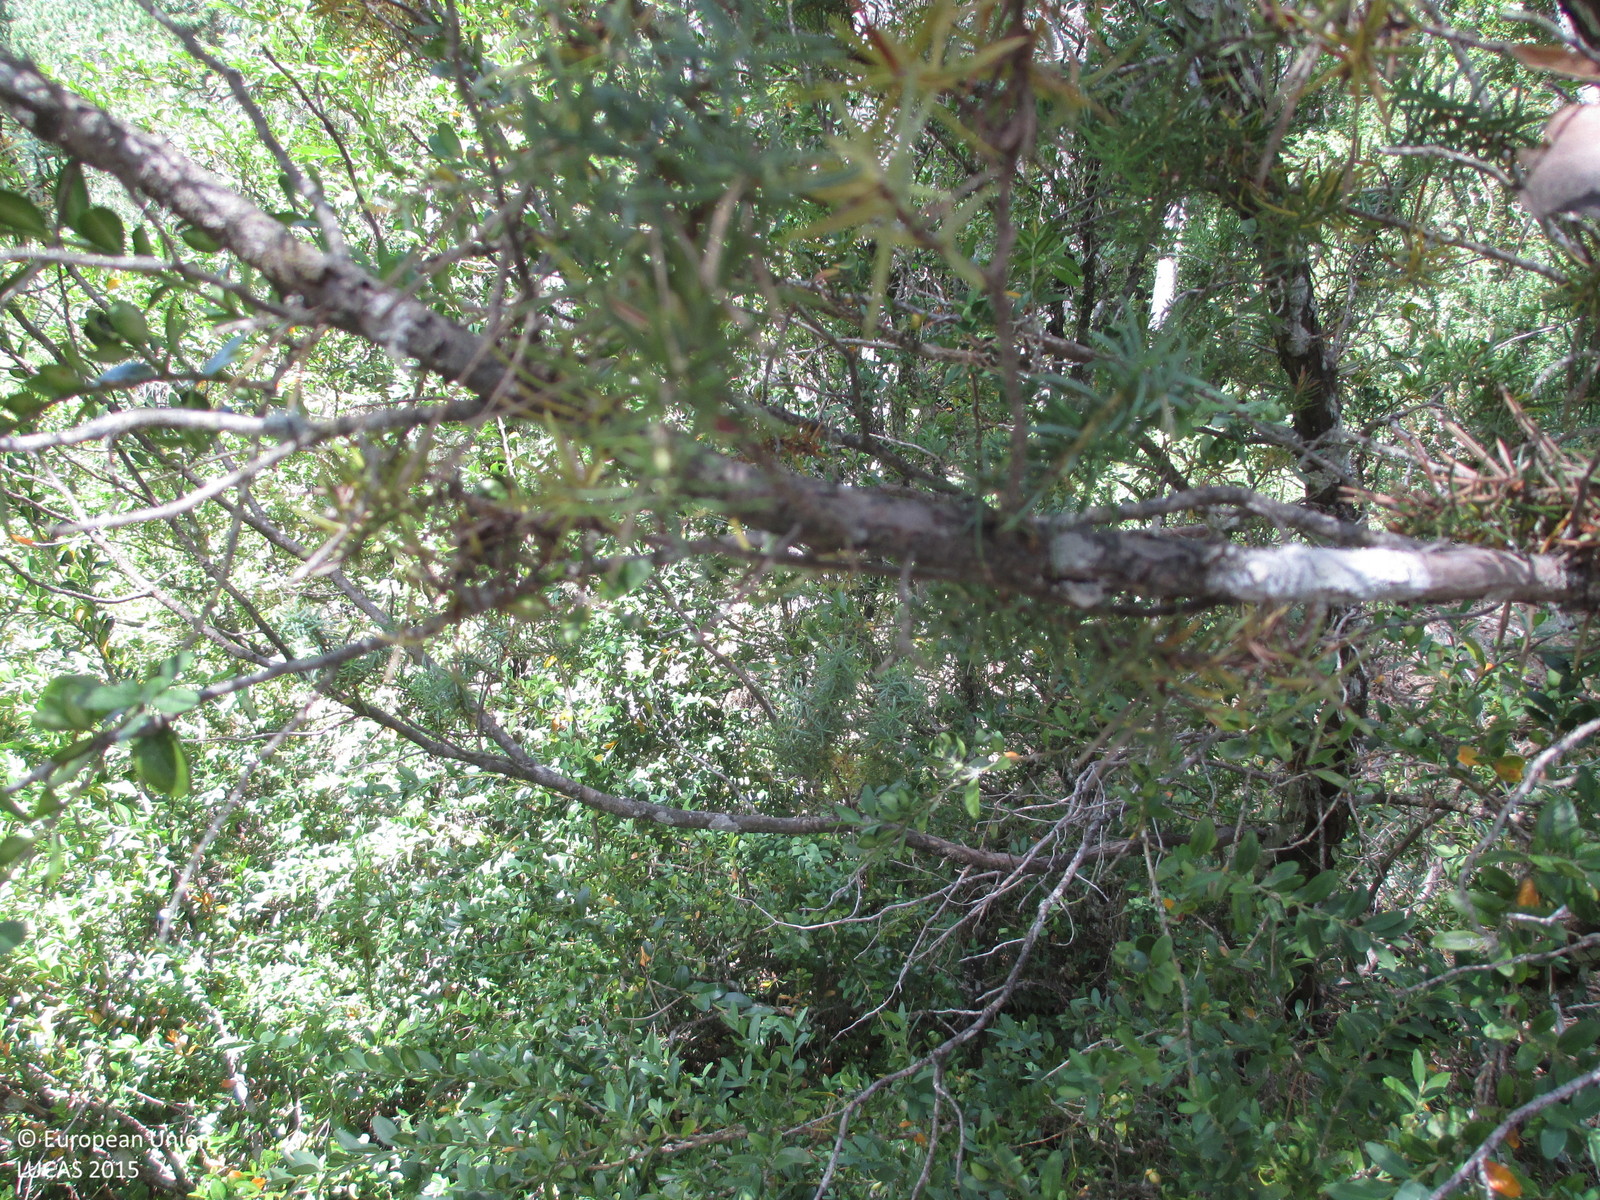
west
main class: Woodland
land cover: Pine dominated coniferous woodland
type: coniferous forest of the mediterranean region
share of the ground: > 75 %
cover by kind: coniferous forest trees 95 %, shrubs 5 %
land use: Semi-natural and natural areas not in use
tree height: > 5 m
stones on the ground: < 10 %
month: July
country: ES
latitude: 42.3503
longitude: -0.2569
